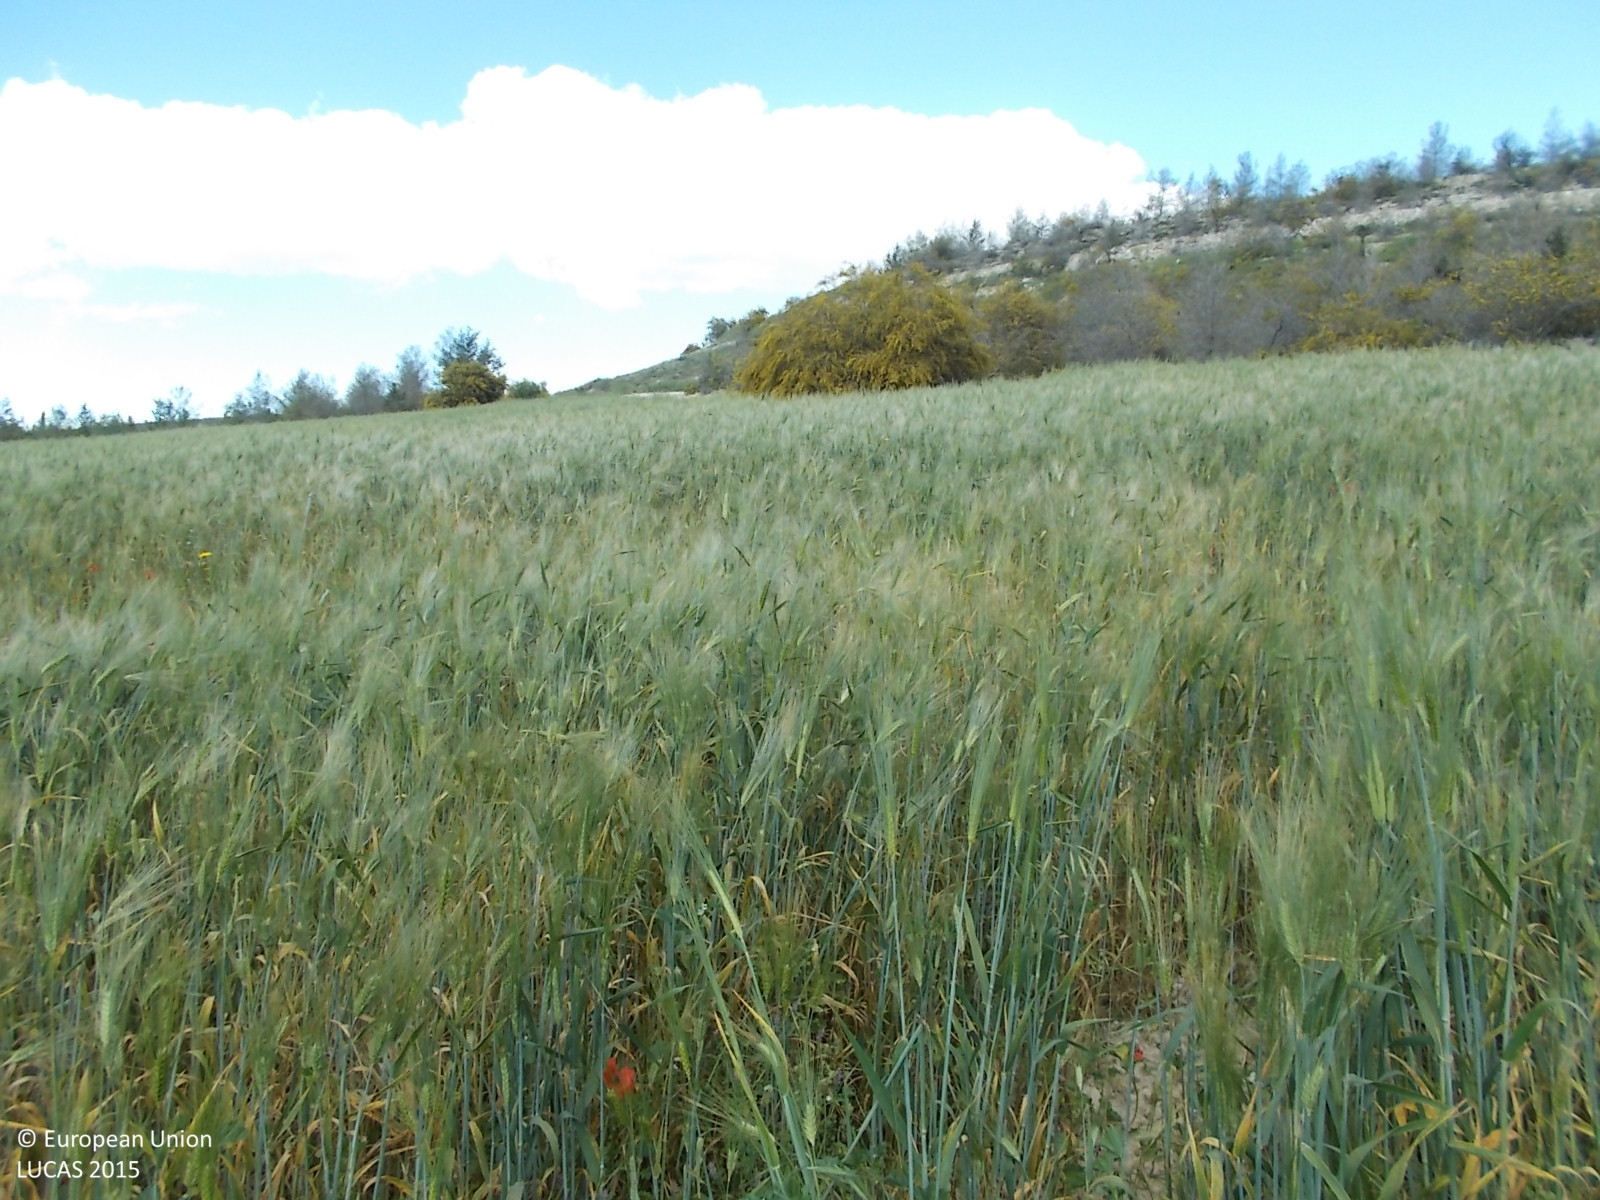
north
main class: Cropland
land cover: Barley
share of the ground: > 75 %
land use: Agriculture (excluding fallow land and kitchen gardens)
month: April
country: CY
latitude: 35.0026
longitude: 33.4998
